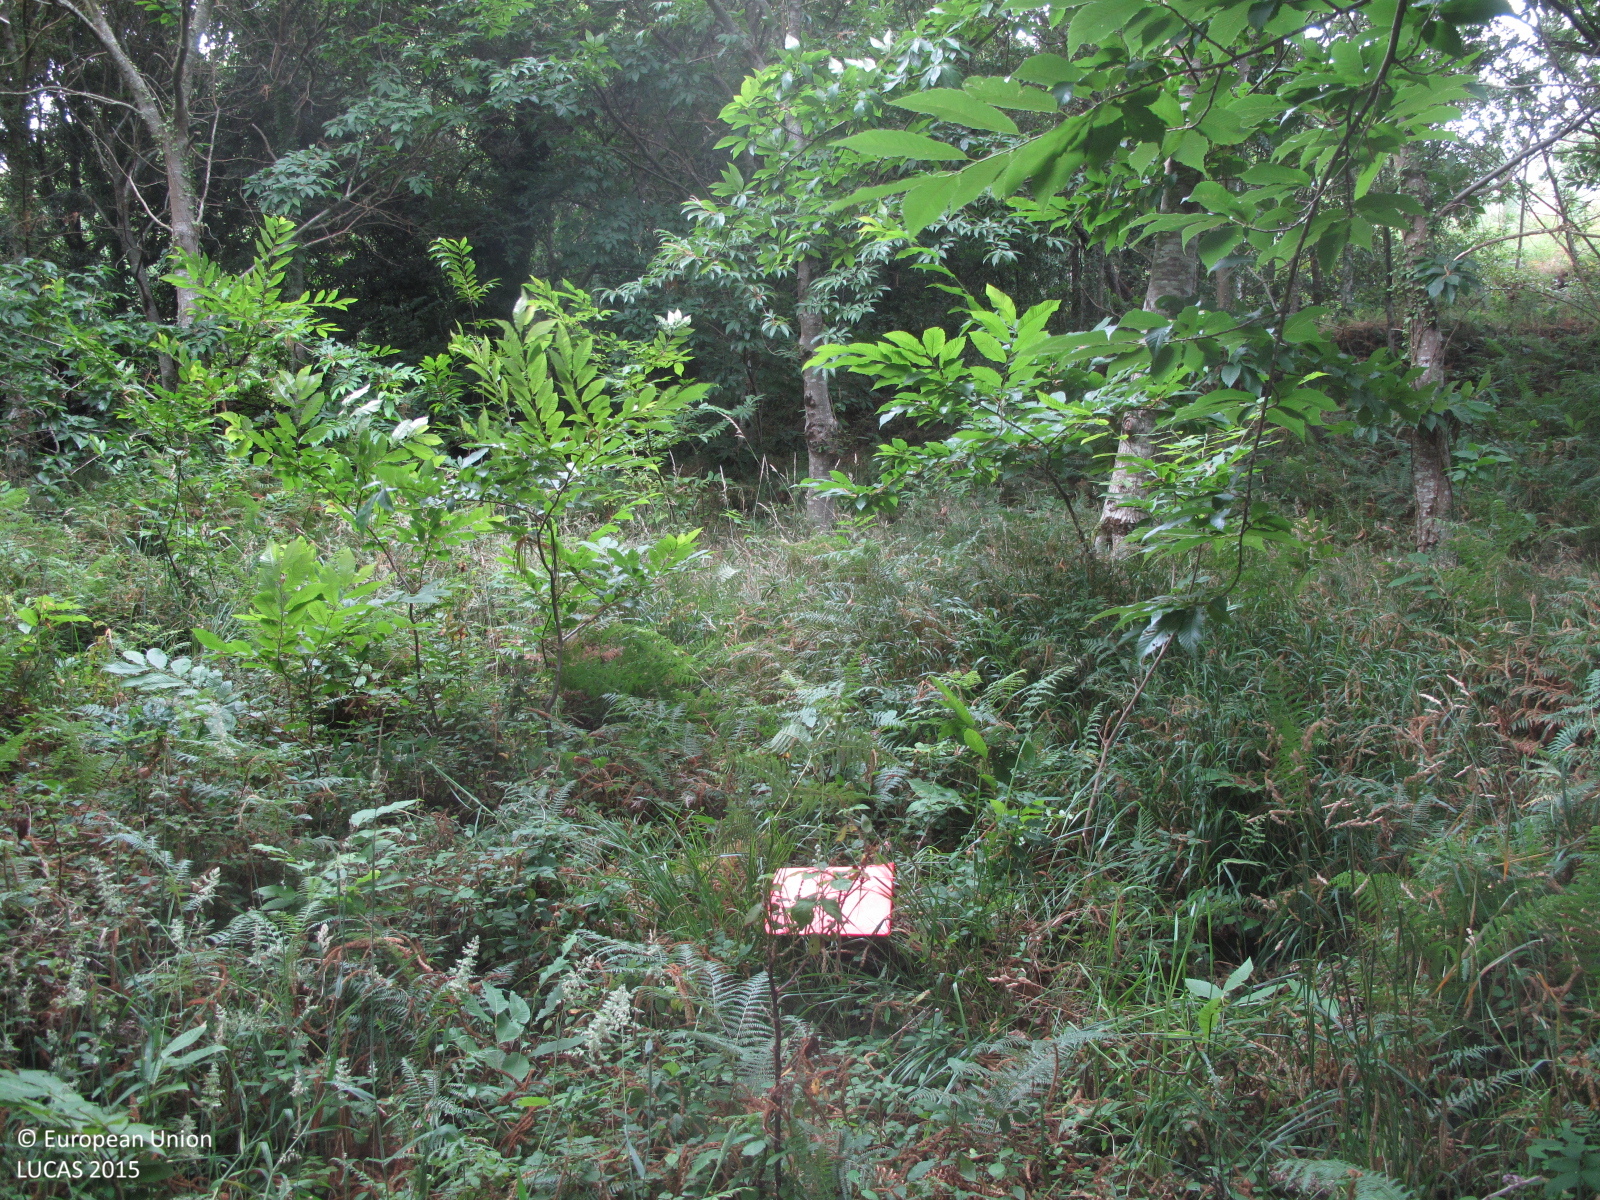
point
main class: Woodland
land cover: Broadleaved woodland
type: thermophilous deciduous forest
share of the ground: > 75 %
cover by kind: broadleaved forest trees 90 %, shrubs 5 %, herbaceous plants 5 %
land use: Forestry
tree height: > 5 m
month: July
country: ES
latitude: 43.1387
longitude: -9.1475
